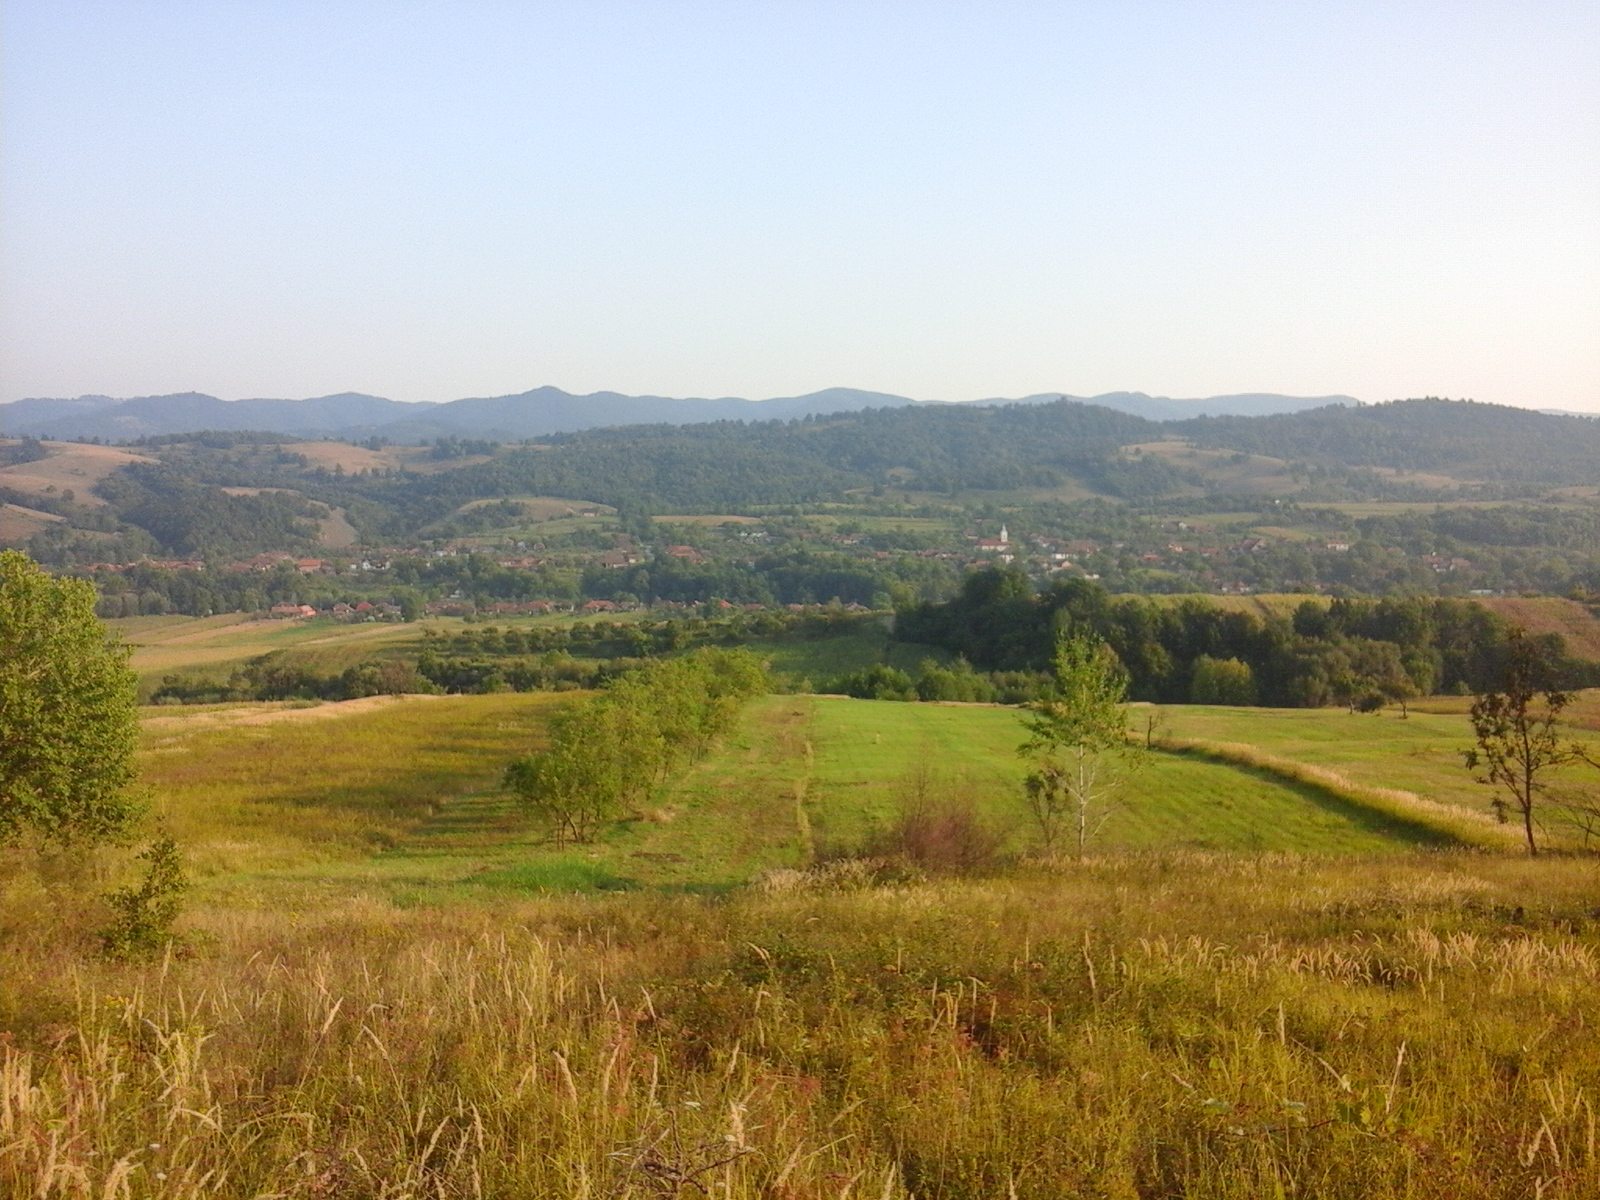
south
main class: Grassland
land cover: Spontaneously vegetated surfaces
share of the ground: > 75 %
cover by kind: herbaceous plants 100 %
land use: Fallow land
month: August
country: RO
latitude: 46.2389
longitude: 22.3022
